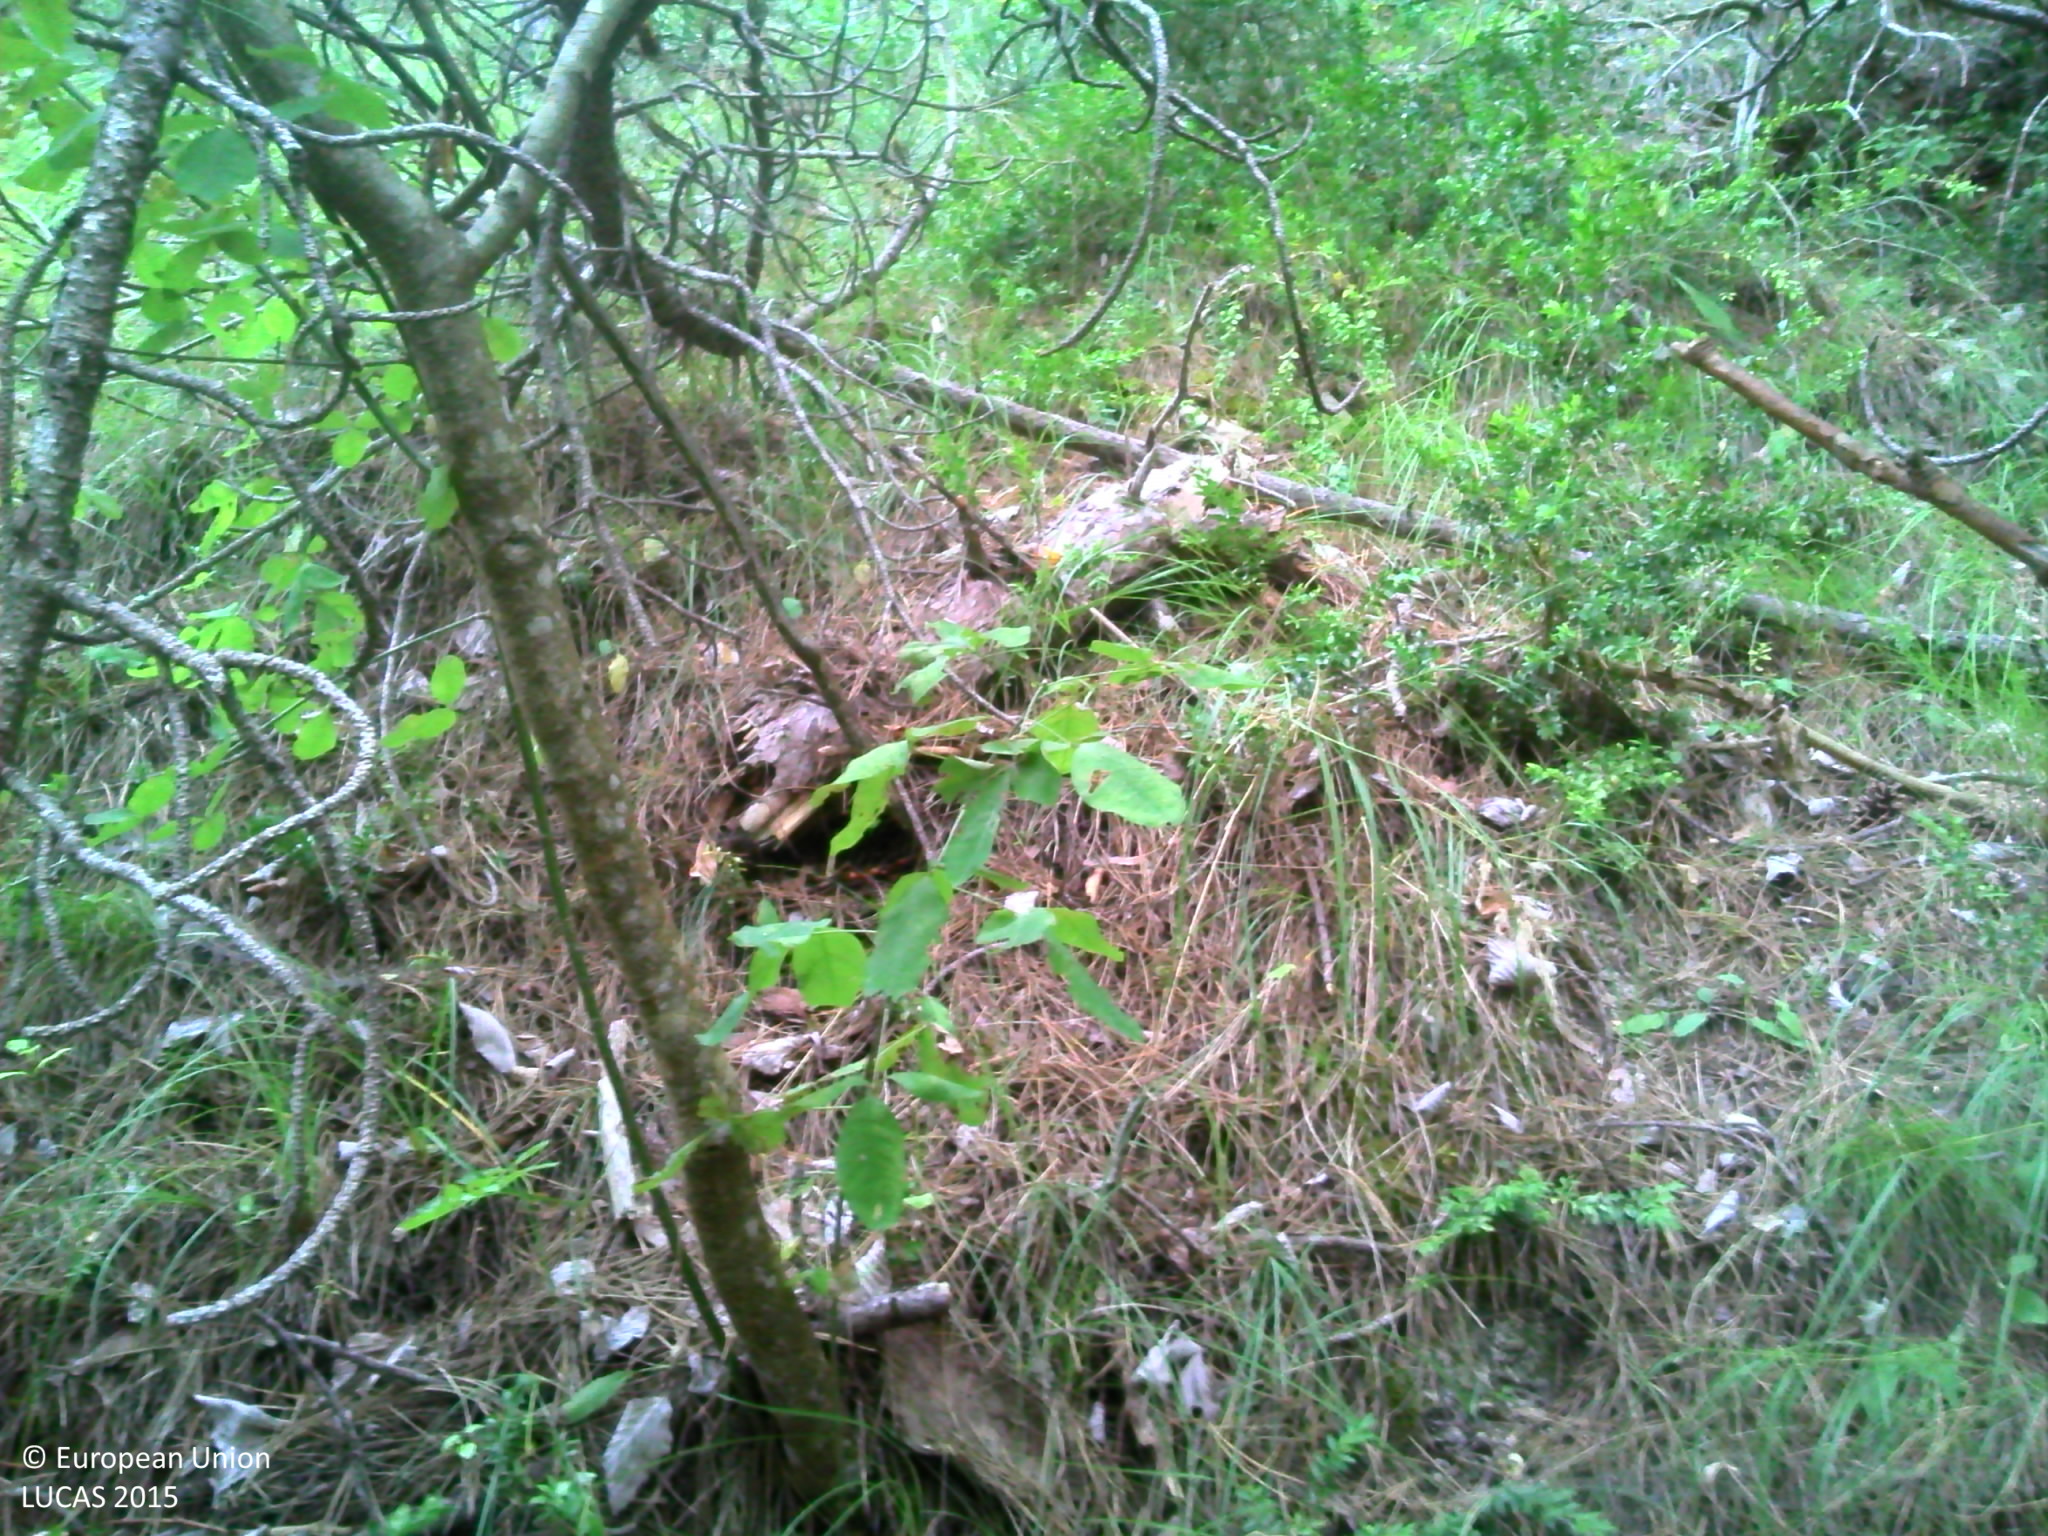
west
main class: Woodland
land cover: Pine dominated coniferous woodland
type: coniferous forest of the mediterranean region
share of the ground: > 75 %
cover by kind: coniferous forest trees 85 %, shrubs 10 %, broadleaved forest trees 5 %
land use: Semi-natural and natural areas not in use
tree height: > 5 m
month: September
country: FR
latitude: 44.6336
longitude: 5.5316
